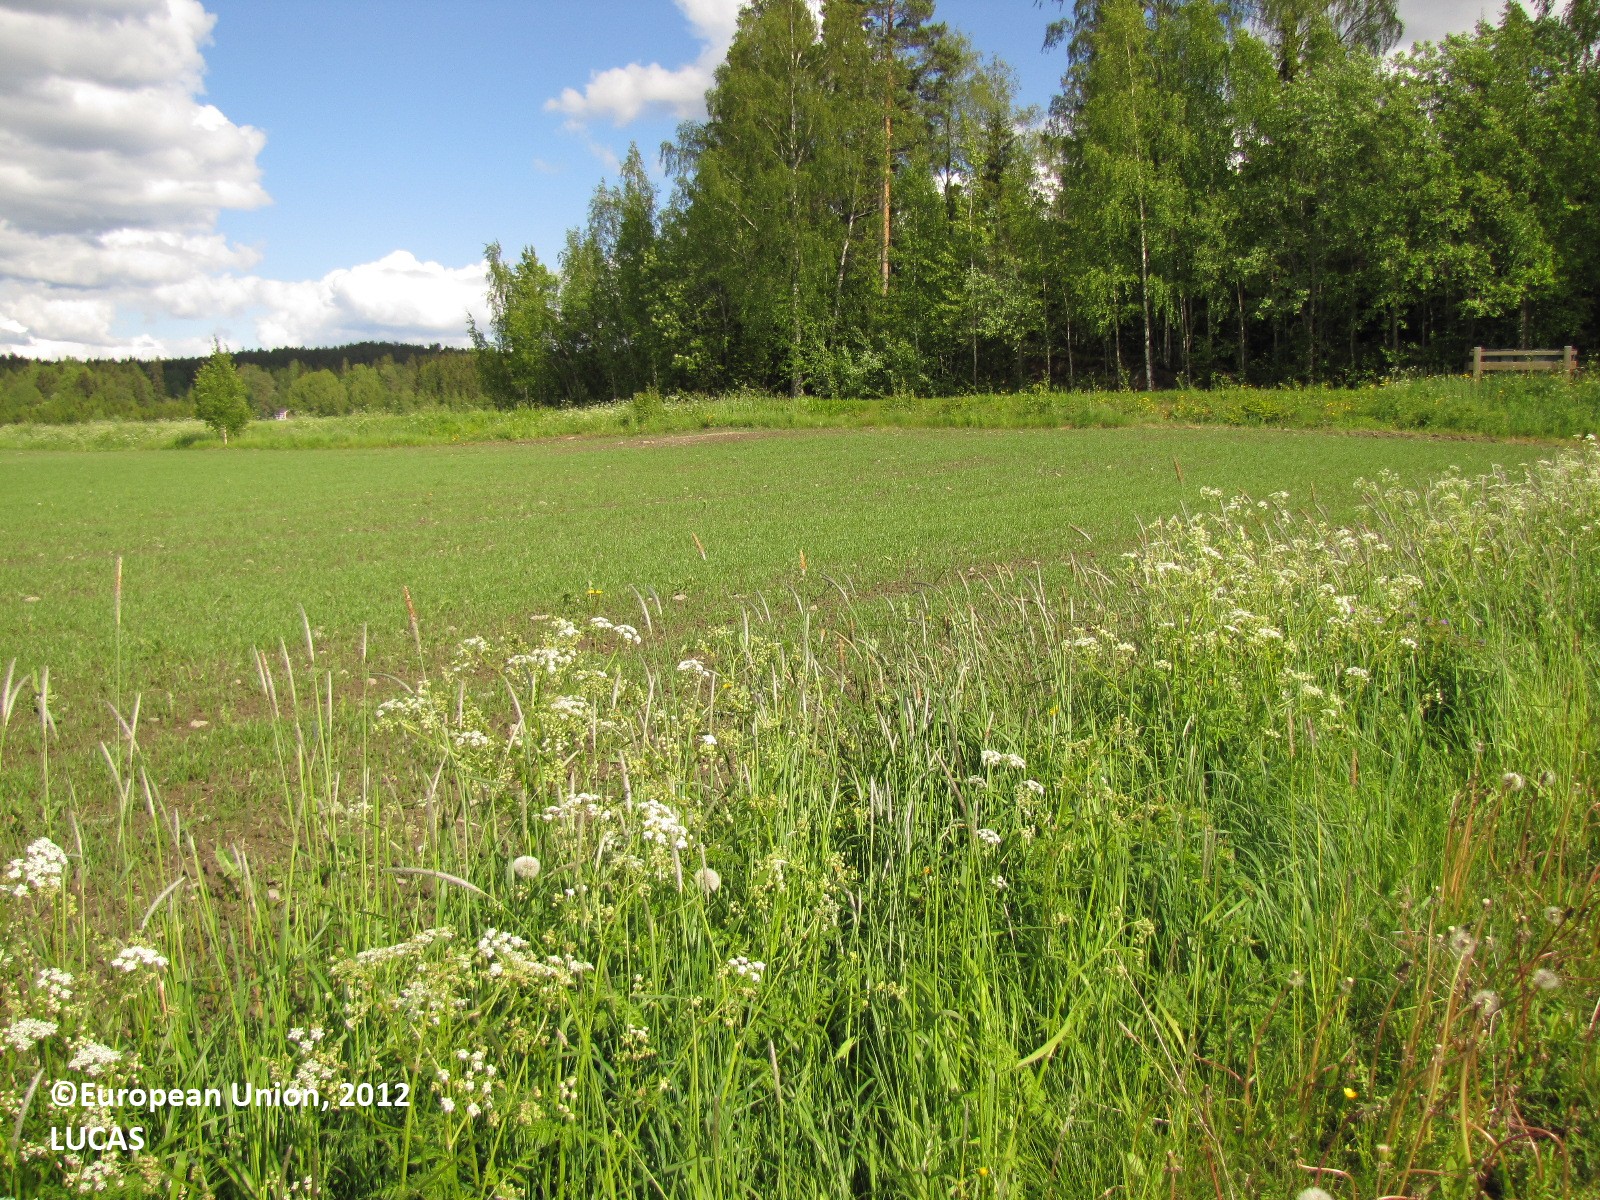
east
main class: Cropland
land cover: Common wheat
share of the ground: 50 - 75 %
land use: Agriculture (excluding fallow land and kitchen gardens)
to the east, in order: Common wheat; Grass margins; Ditches and canals; Grass margins; Common wheat; Grass margins; Ditches and canals; Tracks; Grass margins; Ditches and canals; Grass margins; Temporary grasslands
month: June
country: FI
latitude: 61.4357
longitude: 23.0649
